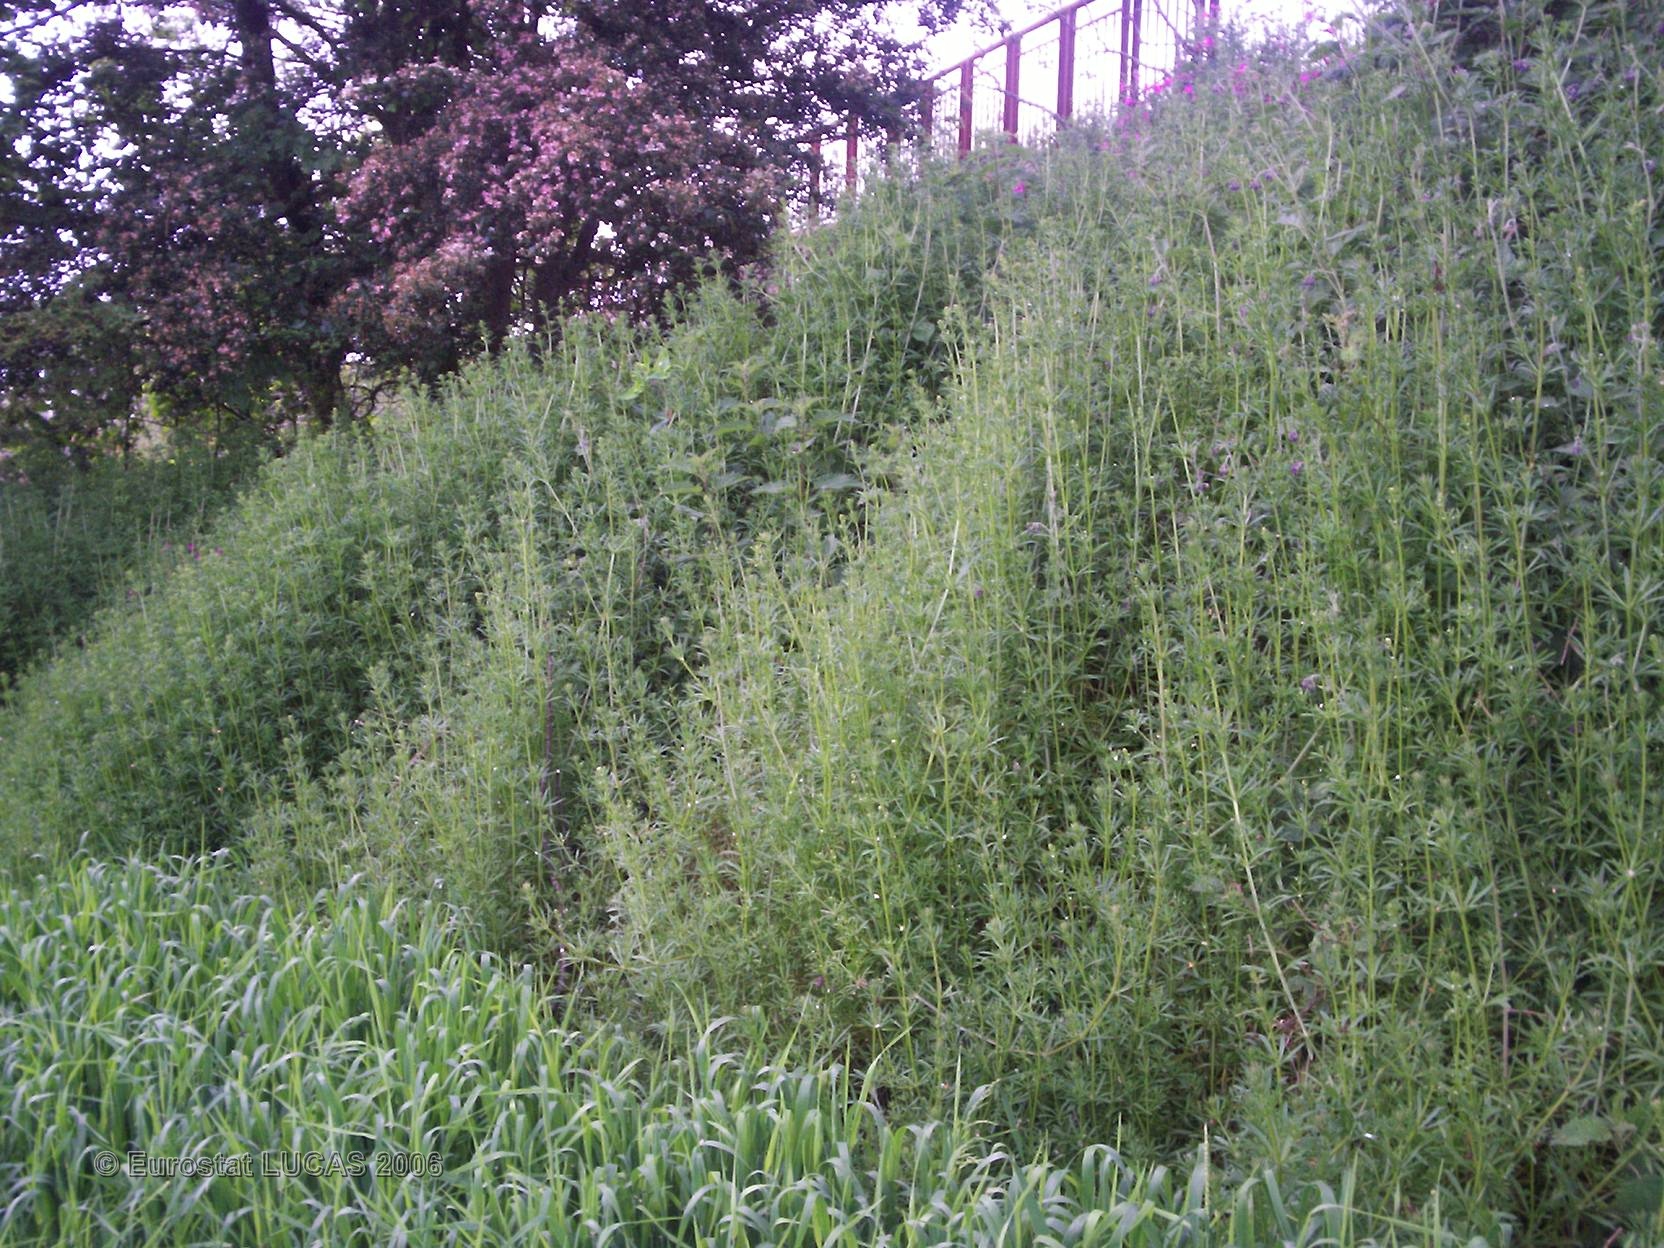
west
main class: Cropland
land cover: Barley
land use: Agriculture (excluding fallow land and kitchen gardens)
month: May
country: FR
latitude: 49.6872
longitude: 0.3941
